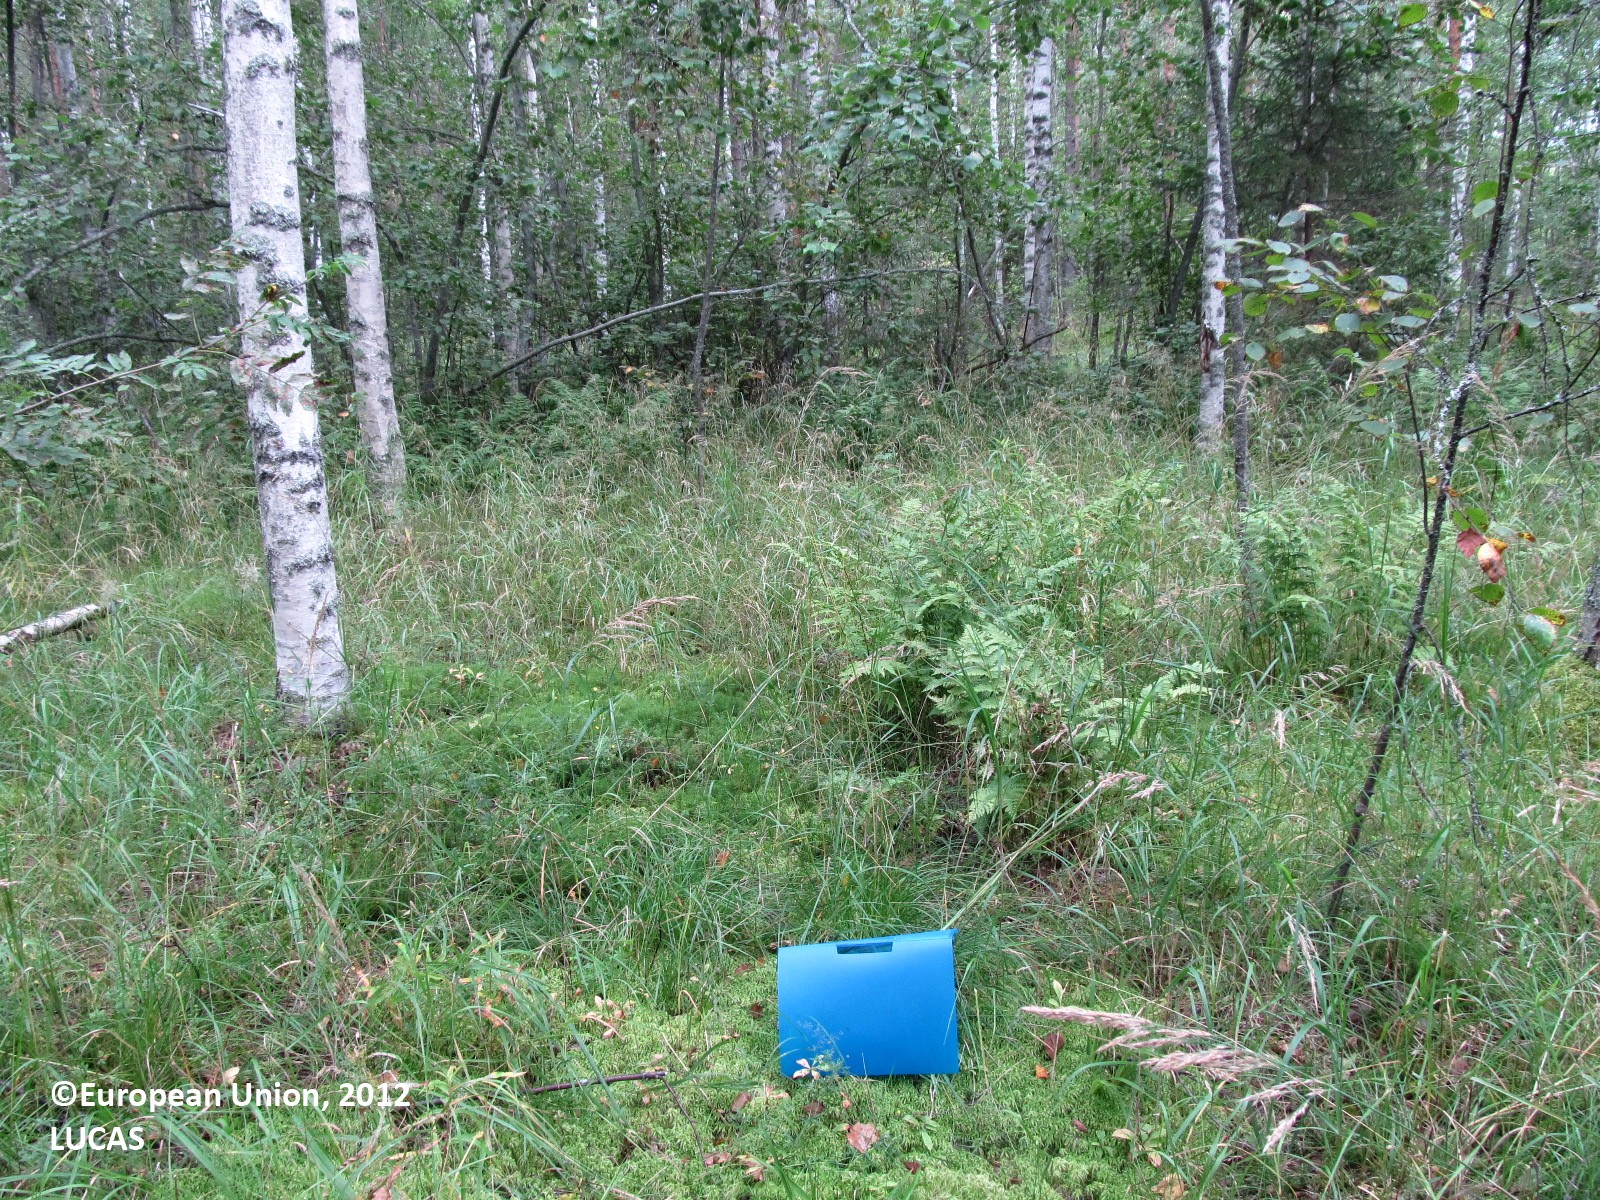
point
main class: Woodland
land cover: Spruce dominated mixed woodland
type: boreal forest
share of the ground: 25 - 50 %
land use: Forestry
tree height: > 5 m
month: August
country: FI
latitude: 62.0109
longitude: 27.4177
